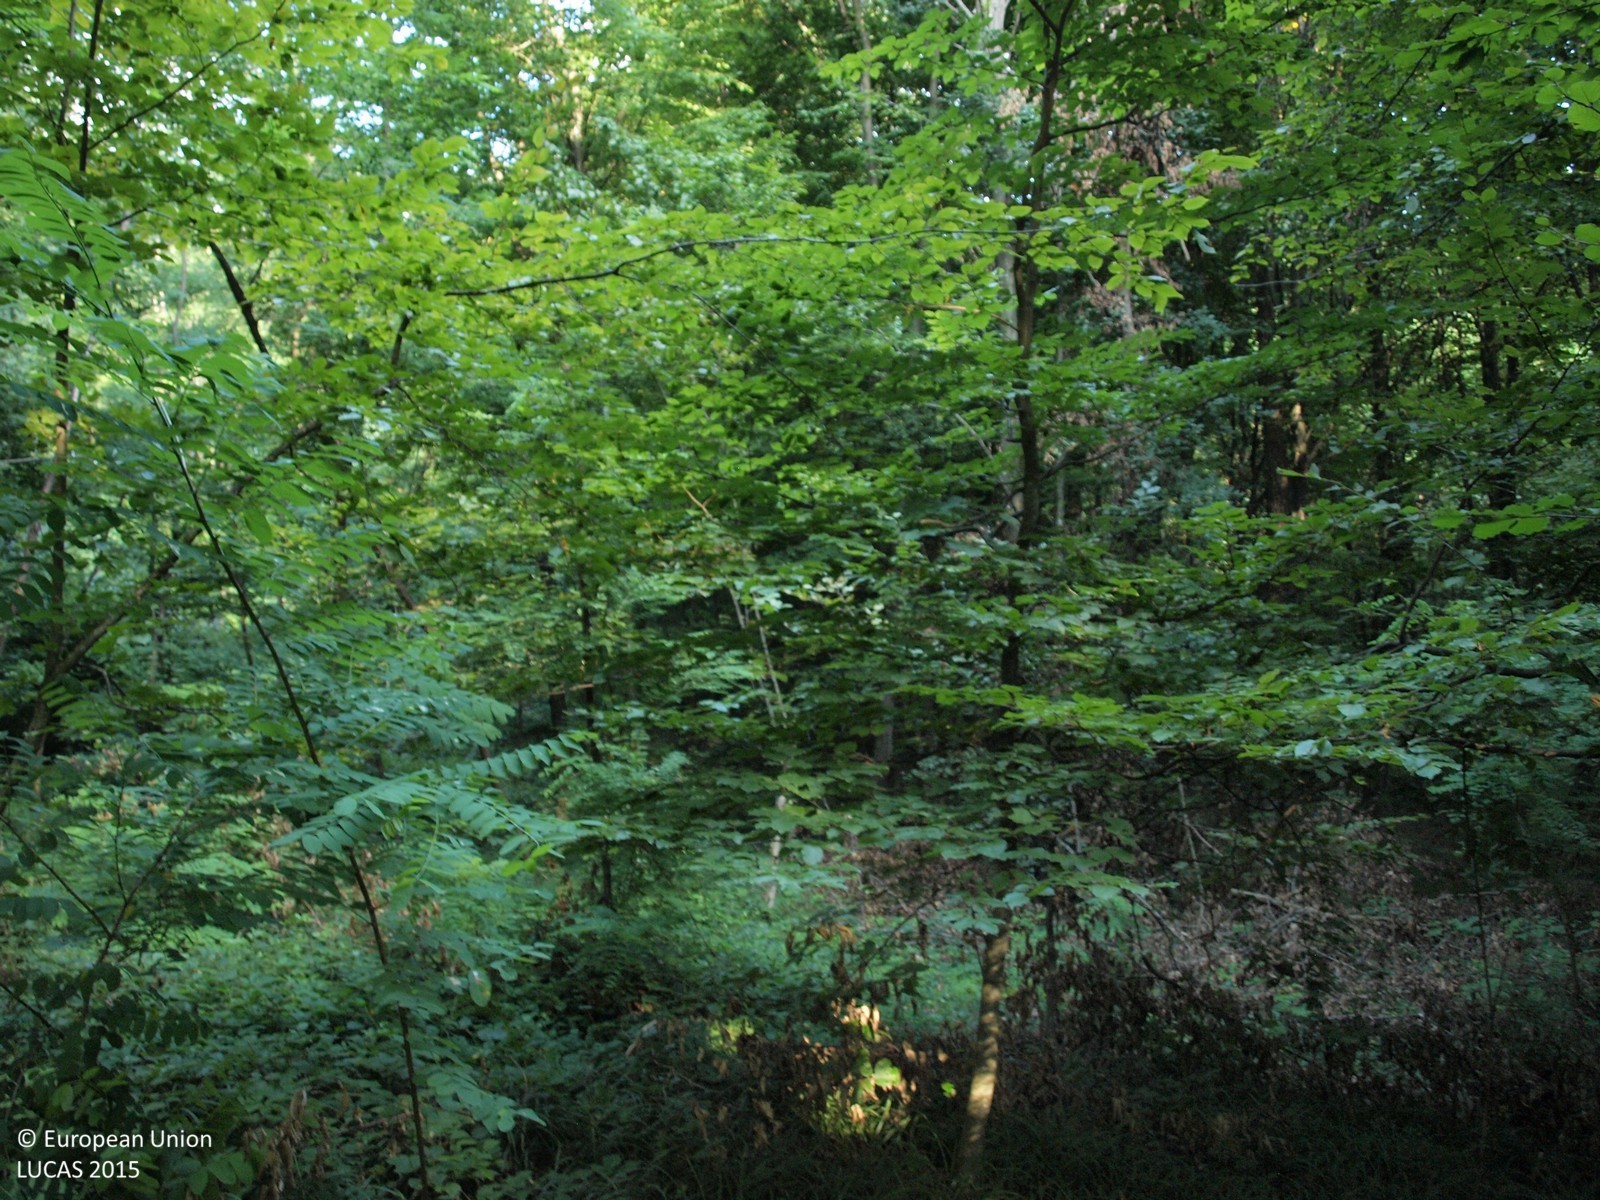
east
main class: Woodland
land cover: Broadleaved woodland
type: beech forest
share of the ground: > 75 %
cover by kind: broadleaved forest trees 100 %
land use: Forestry
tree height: > 5 m
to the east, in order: Broadleaved woodland; Shrubland with sparse tree cover
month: August
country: HR
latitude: 46.0582
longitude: 16.5795
